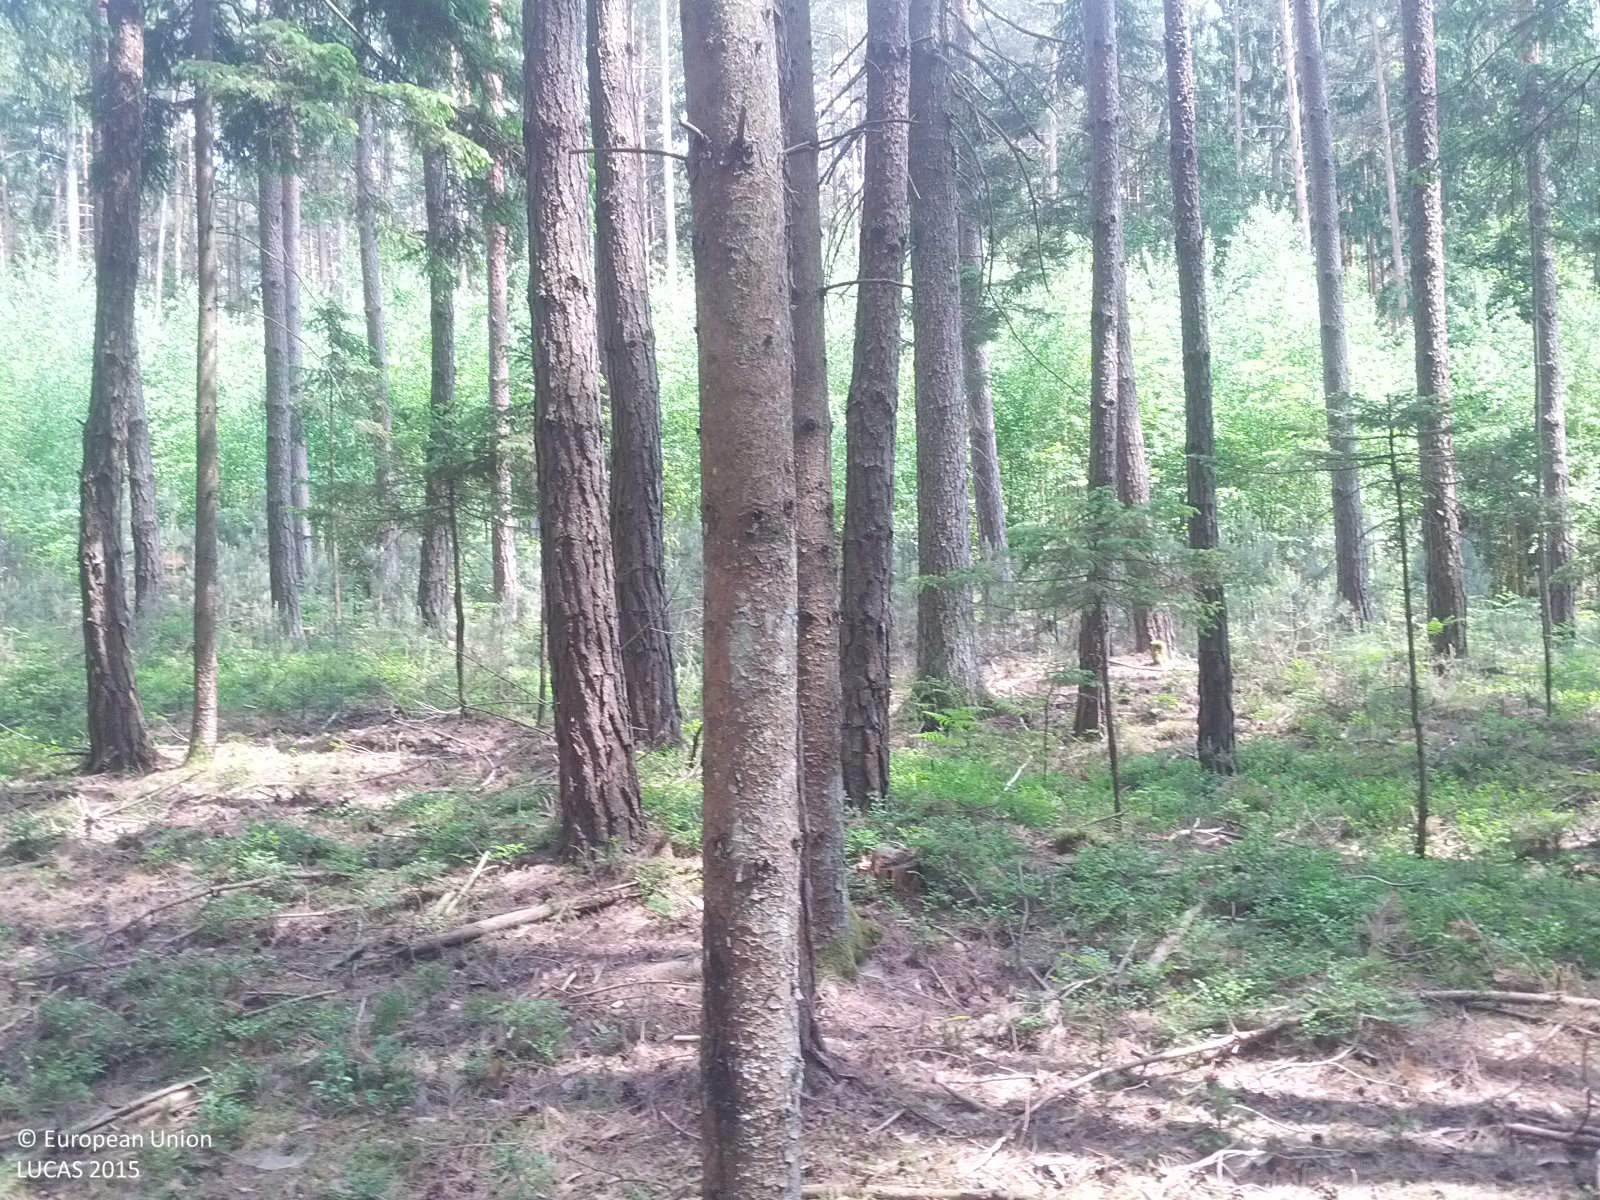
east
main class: Woodland
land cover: Pine dominated coniferous woodland
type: boreal forest
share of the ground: > 75 %
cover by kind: coniferous forest trees 80 %, lichens and mosses 10 %, shrubs 5 %, herbaceous plants 5 %
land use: Forestry
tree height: > 5 m
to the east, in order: Pine dominated coniferous woodland; Broadleaved woodland; Pine dominated mixed woodland; Tracks; Pine dominated mixed woodland; Pine dominated coniferous woodland
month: May
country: AT
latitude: 47.3311
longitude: 16.1290
